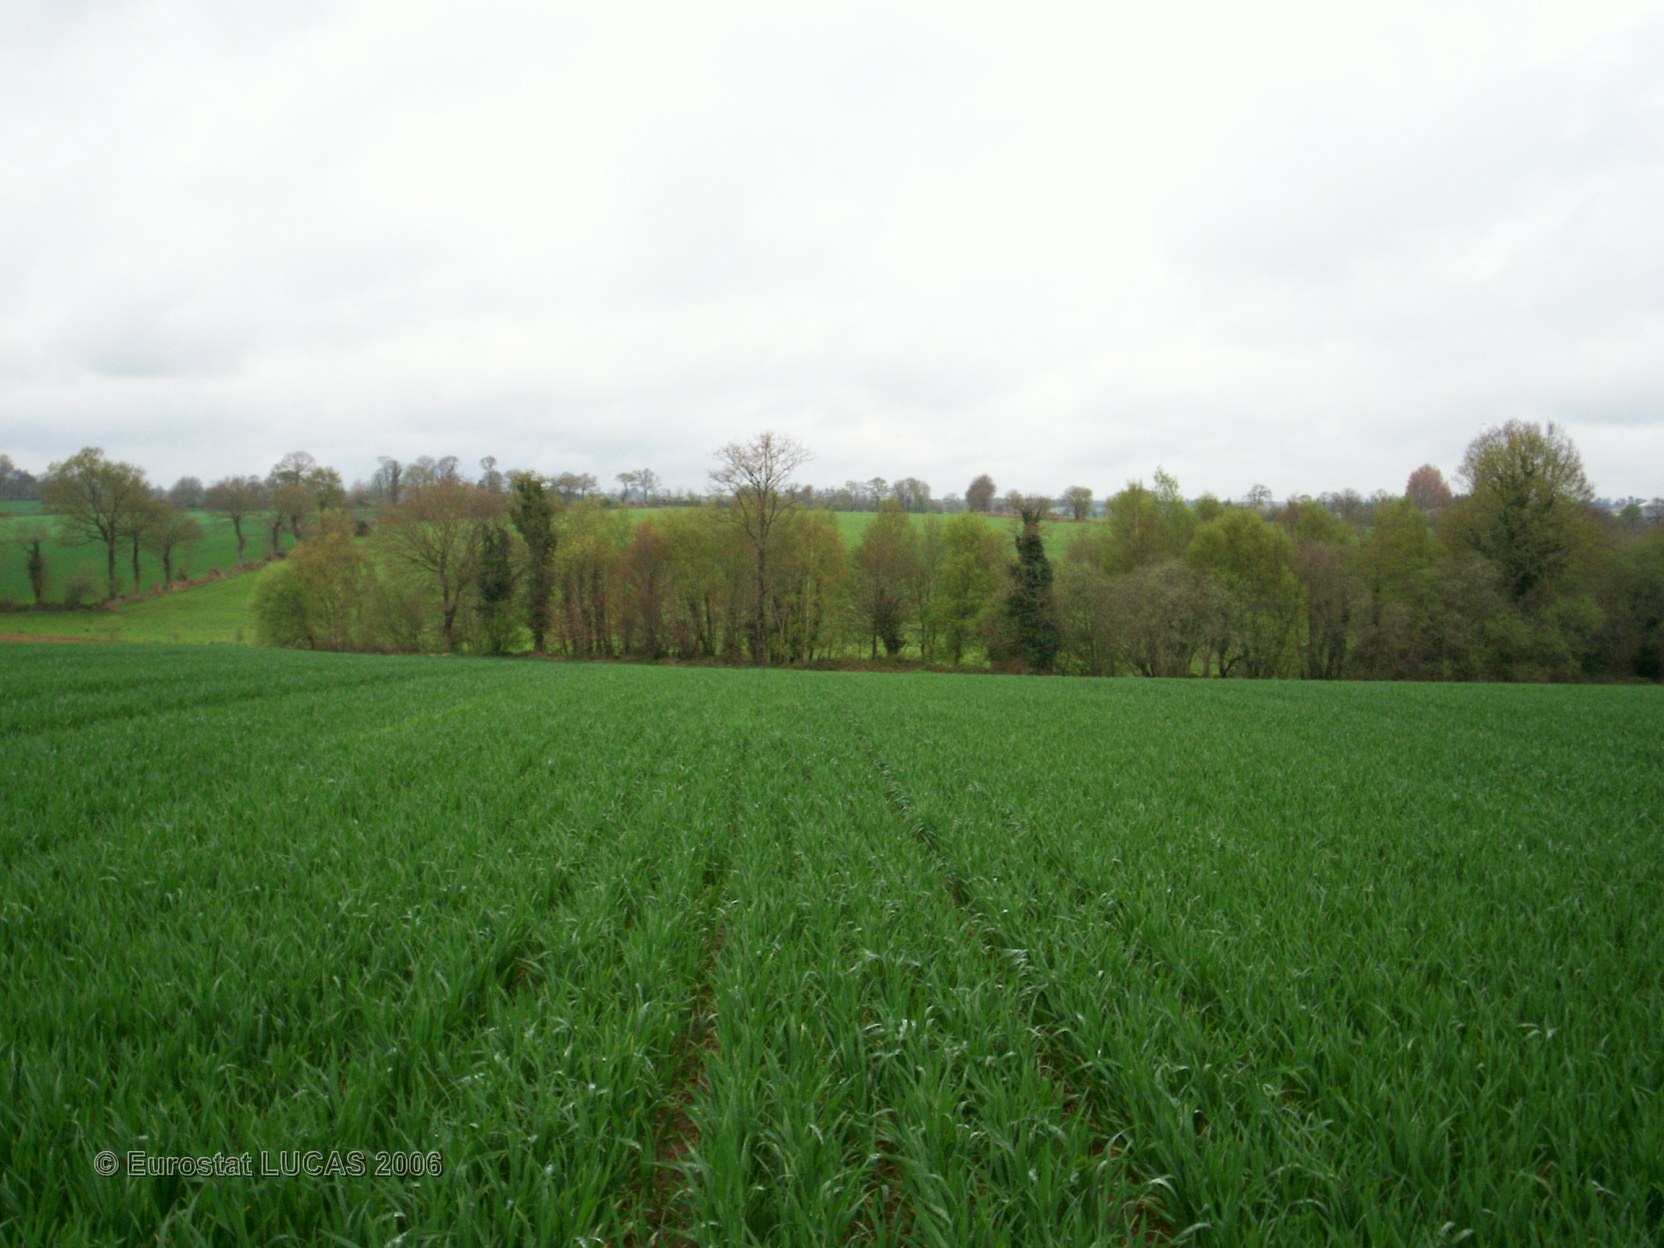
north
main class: Cropland
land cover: Triticale
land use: Agriculture (excluding fallow land and kitchen gardens)
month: April
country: FR
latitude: 48.1706
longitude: -2.4440
